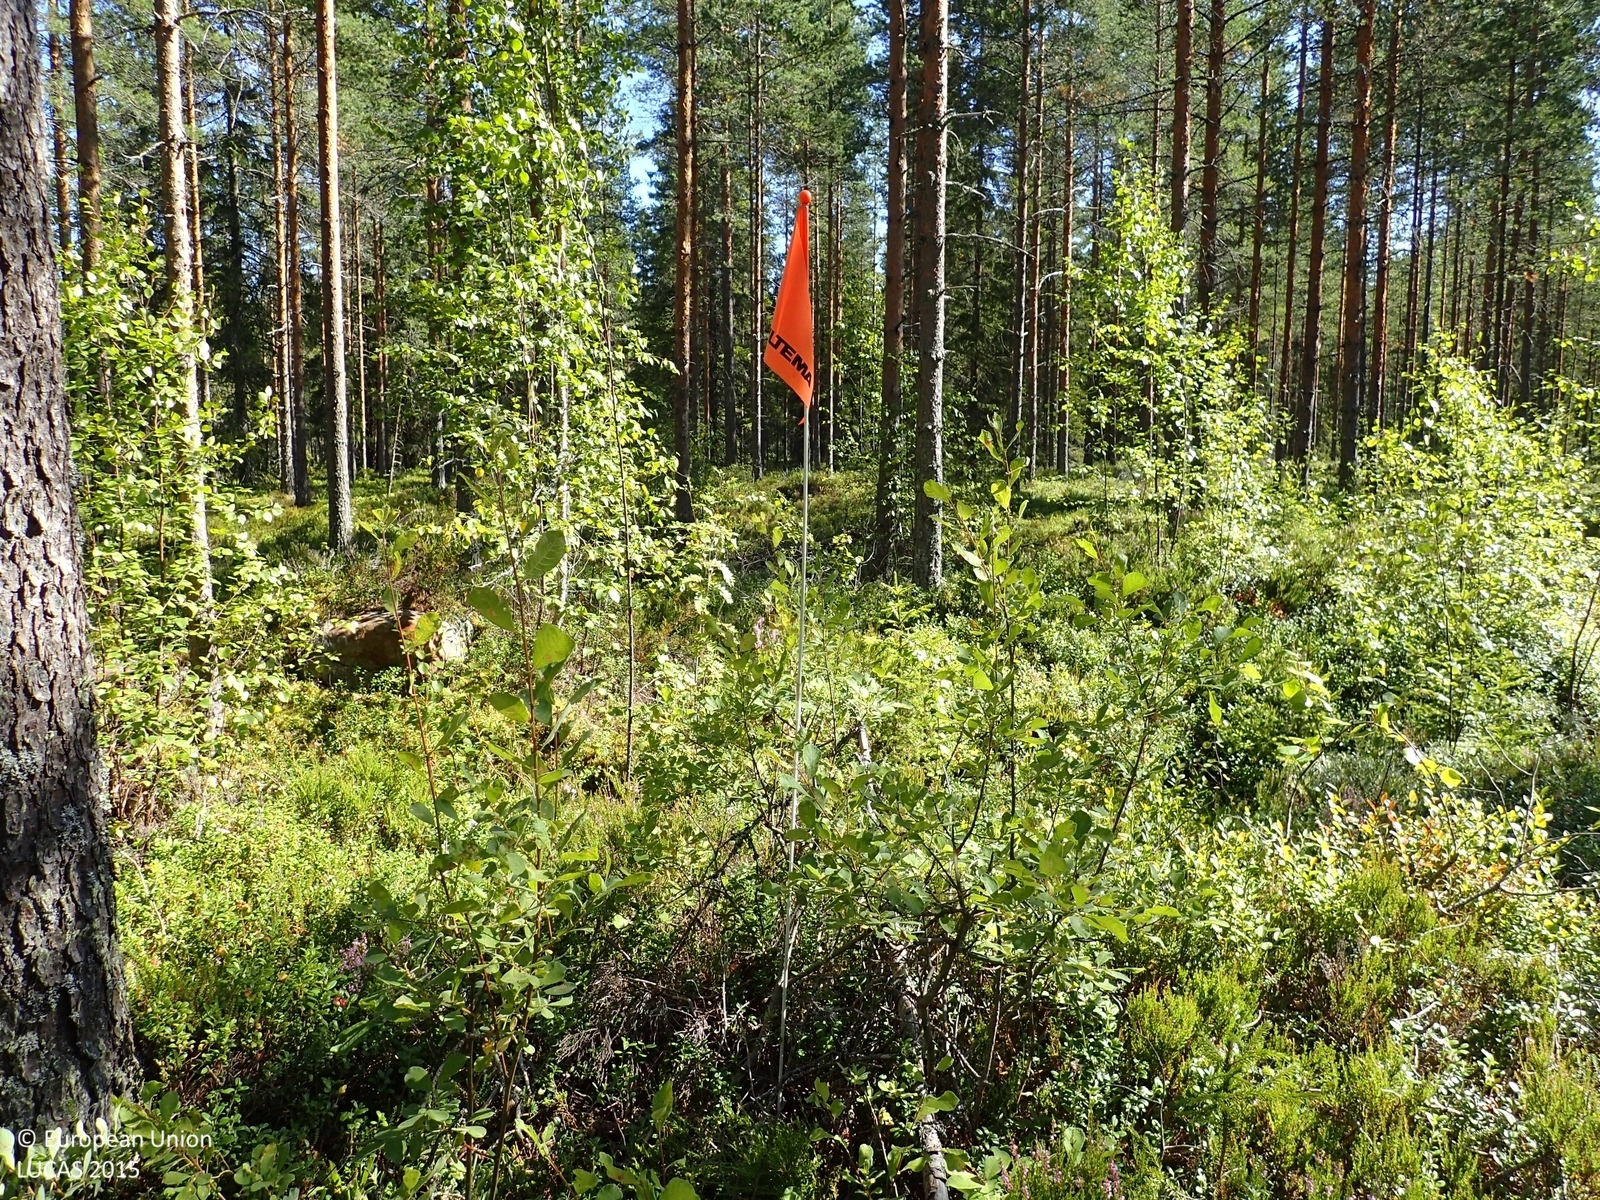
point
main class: Woodland
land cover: Pine dominated coniferous woodland
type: boreal forest
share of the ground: 50 - 75 %
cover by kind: coniferous forest trees 60 %, shrubs 25 %, broadleaved forest trees 10 %, lichens and mosses 5 %
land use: Forestry
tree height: > 5 m
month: August
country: FI
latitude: 62.5919
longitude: 21.9455
